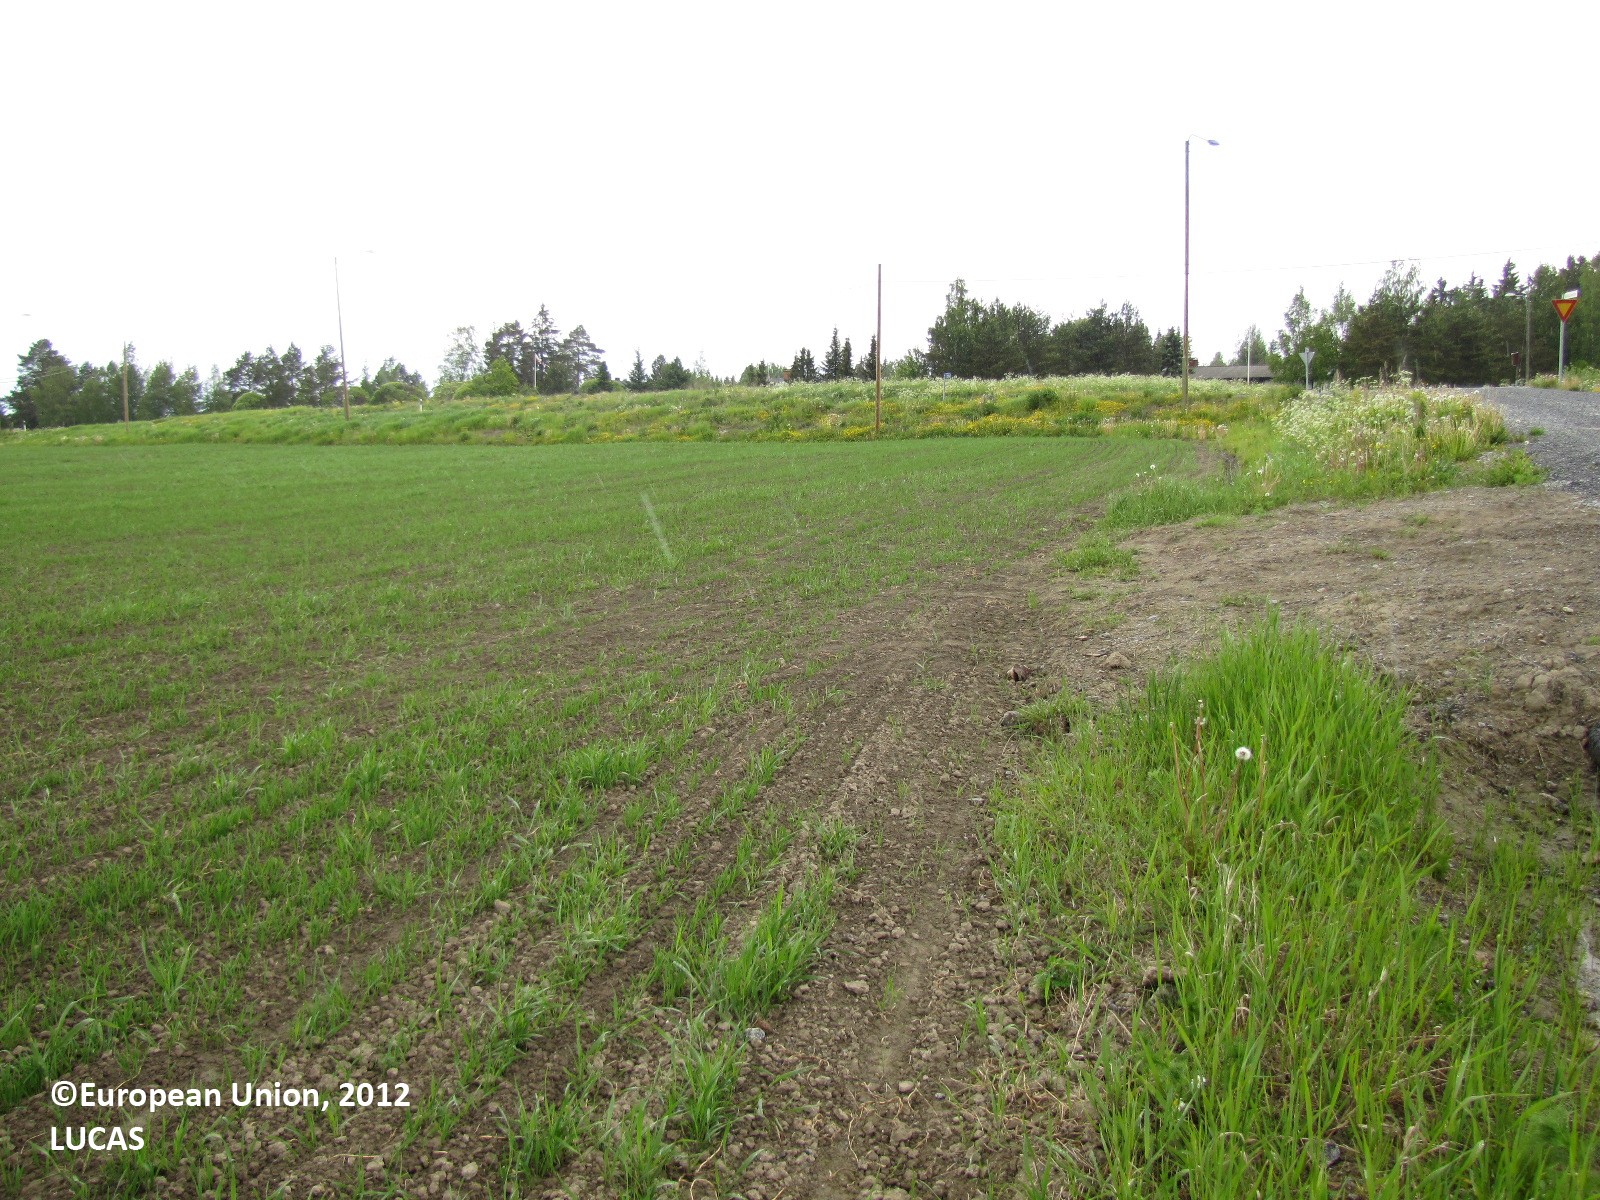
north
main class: Cropland
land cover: Common wheat
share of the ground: 25 - 50 %
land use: Agriculture (excluding fallow land and kitchen gardens)
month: June
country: FI
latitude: 61.2826
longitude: 23.5331
